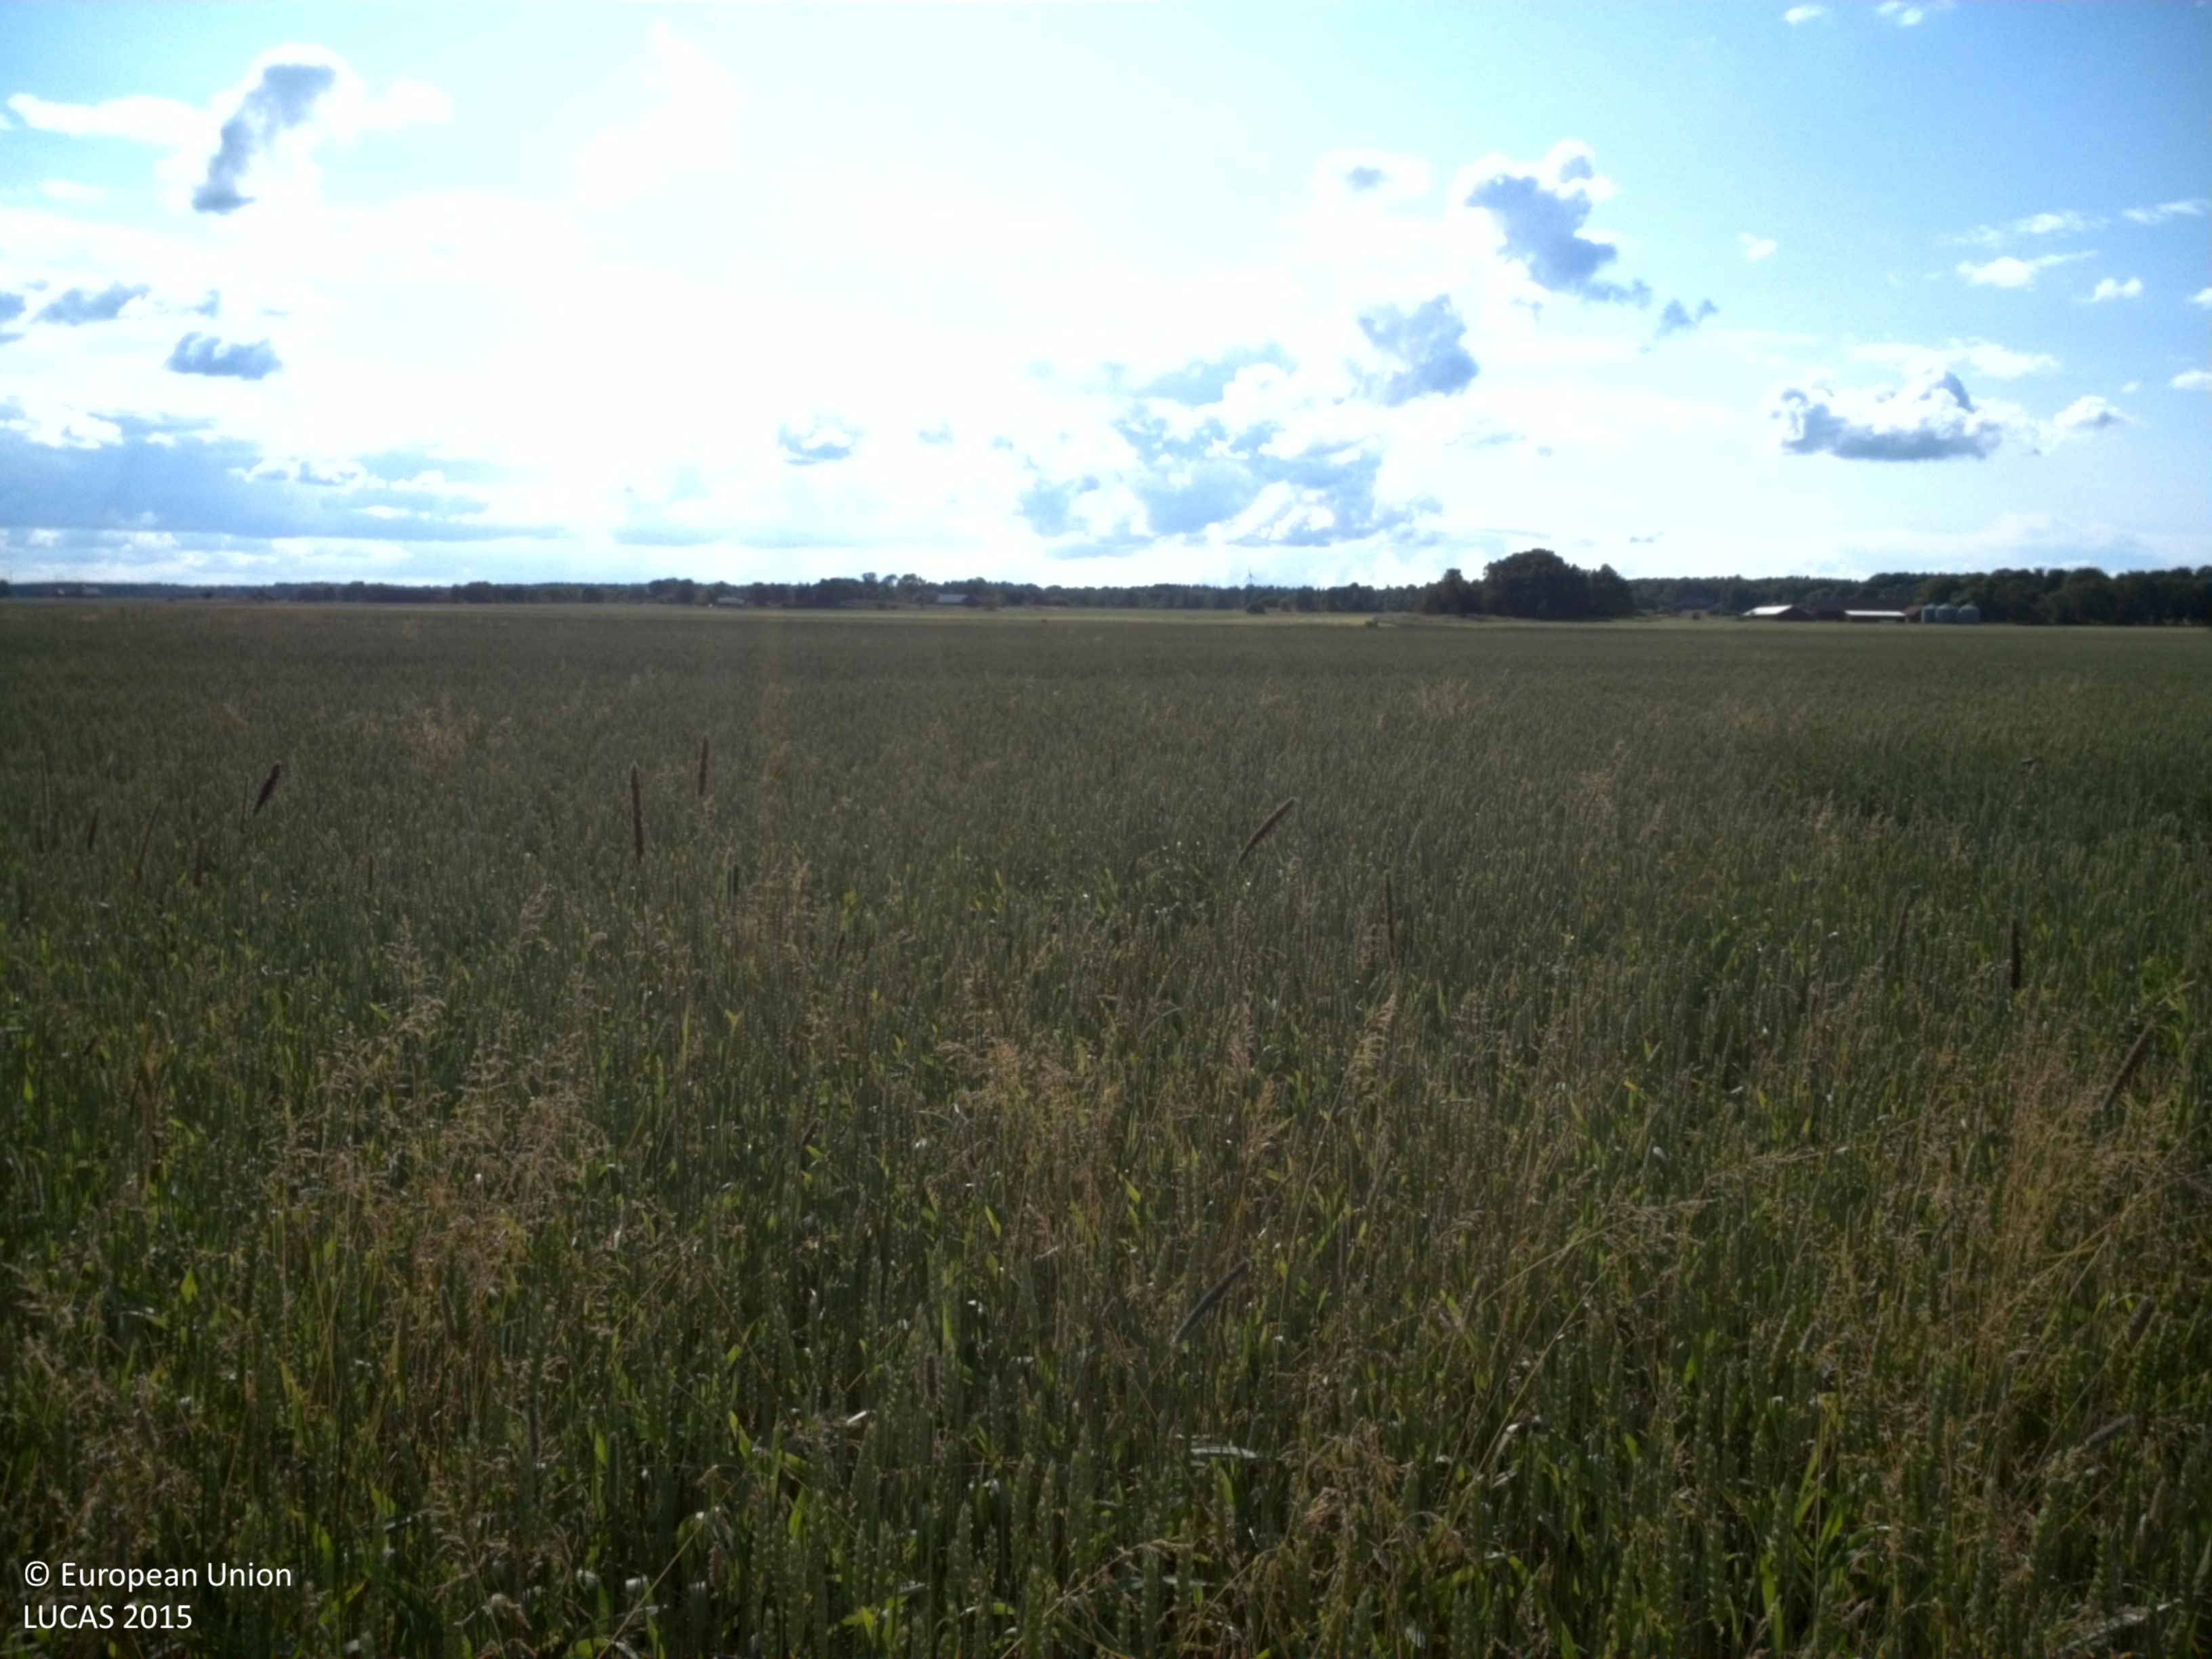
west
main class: Cropland
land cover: Common wheat
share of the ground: > 75 %
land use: Agriculture (excluding fallow land and kitchen gardens)
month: July
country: SE
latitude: 58.6102
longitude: 14.0040
